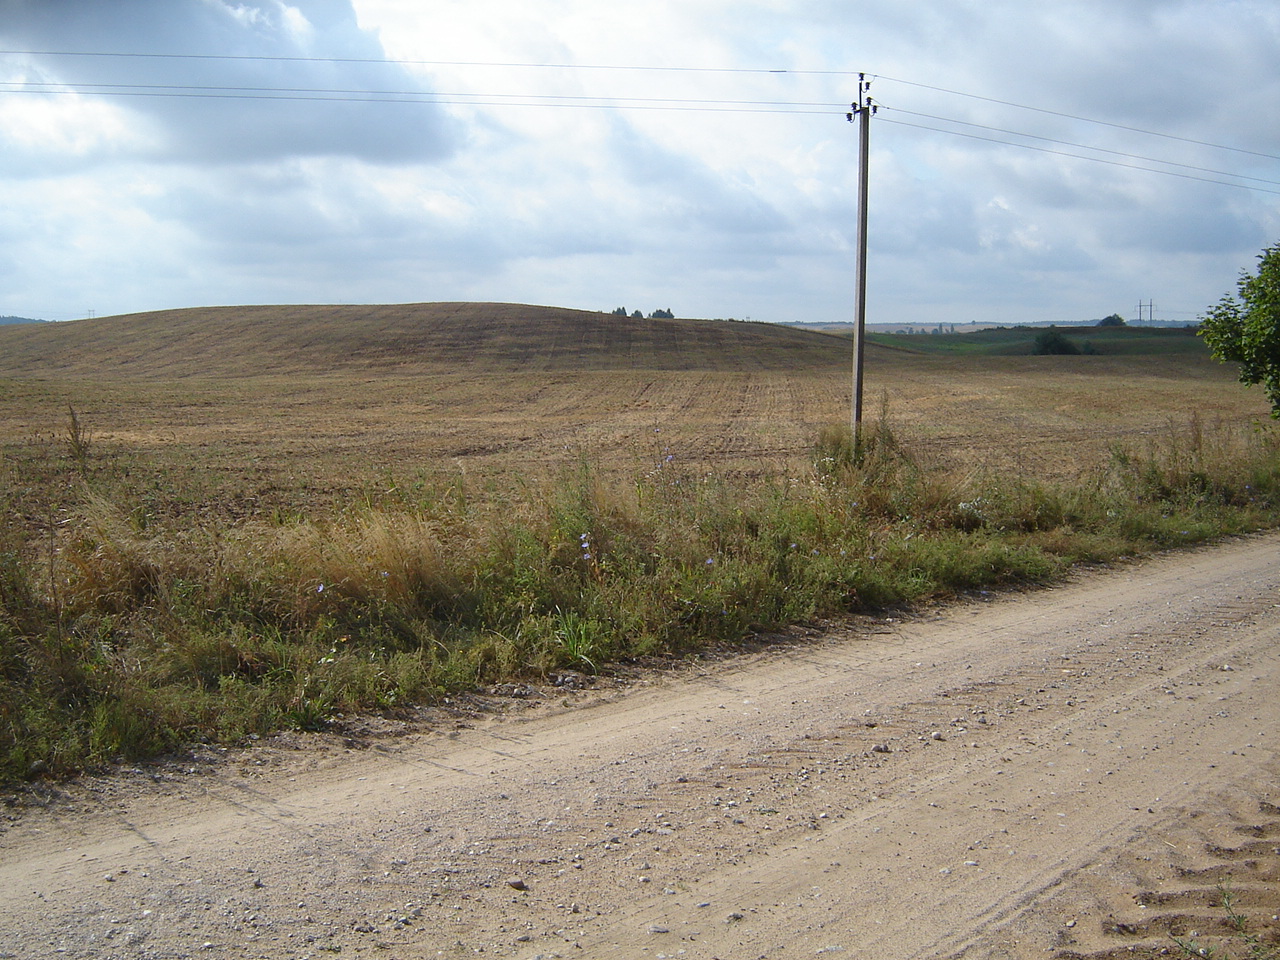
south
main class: Grassland
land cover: Grassland with sparse tree/shrub cover
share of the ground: > 75 %
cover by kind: herbaceous plants 90 %, coniferous forest trees 5 %, shrubs 5 %
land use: Fallow land
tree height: > 5 m
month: August
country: LT
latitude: 54.7280
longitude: 24.7194
